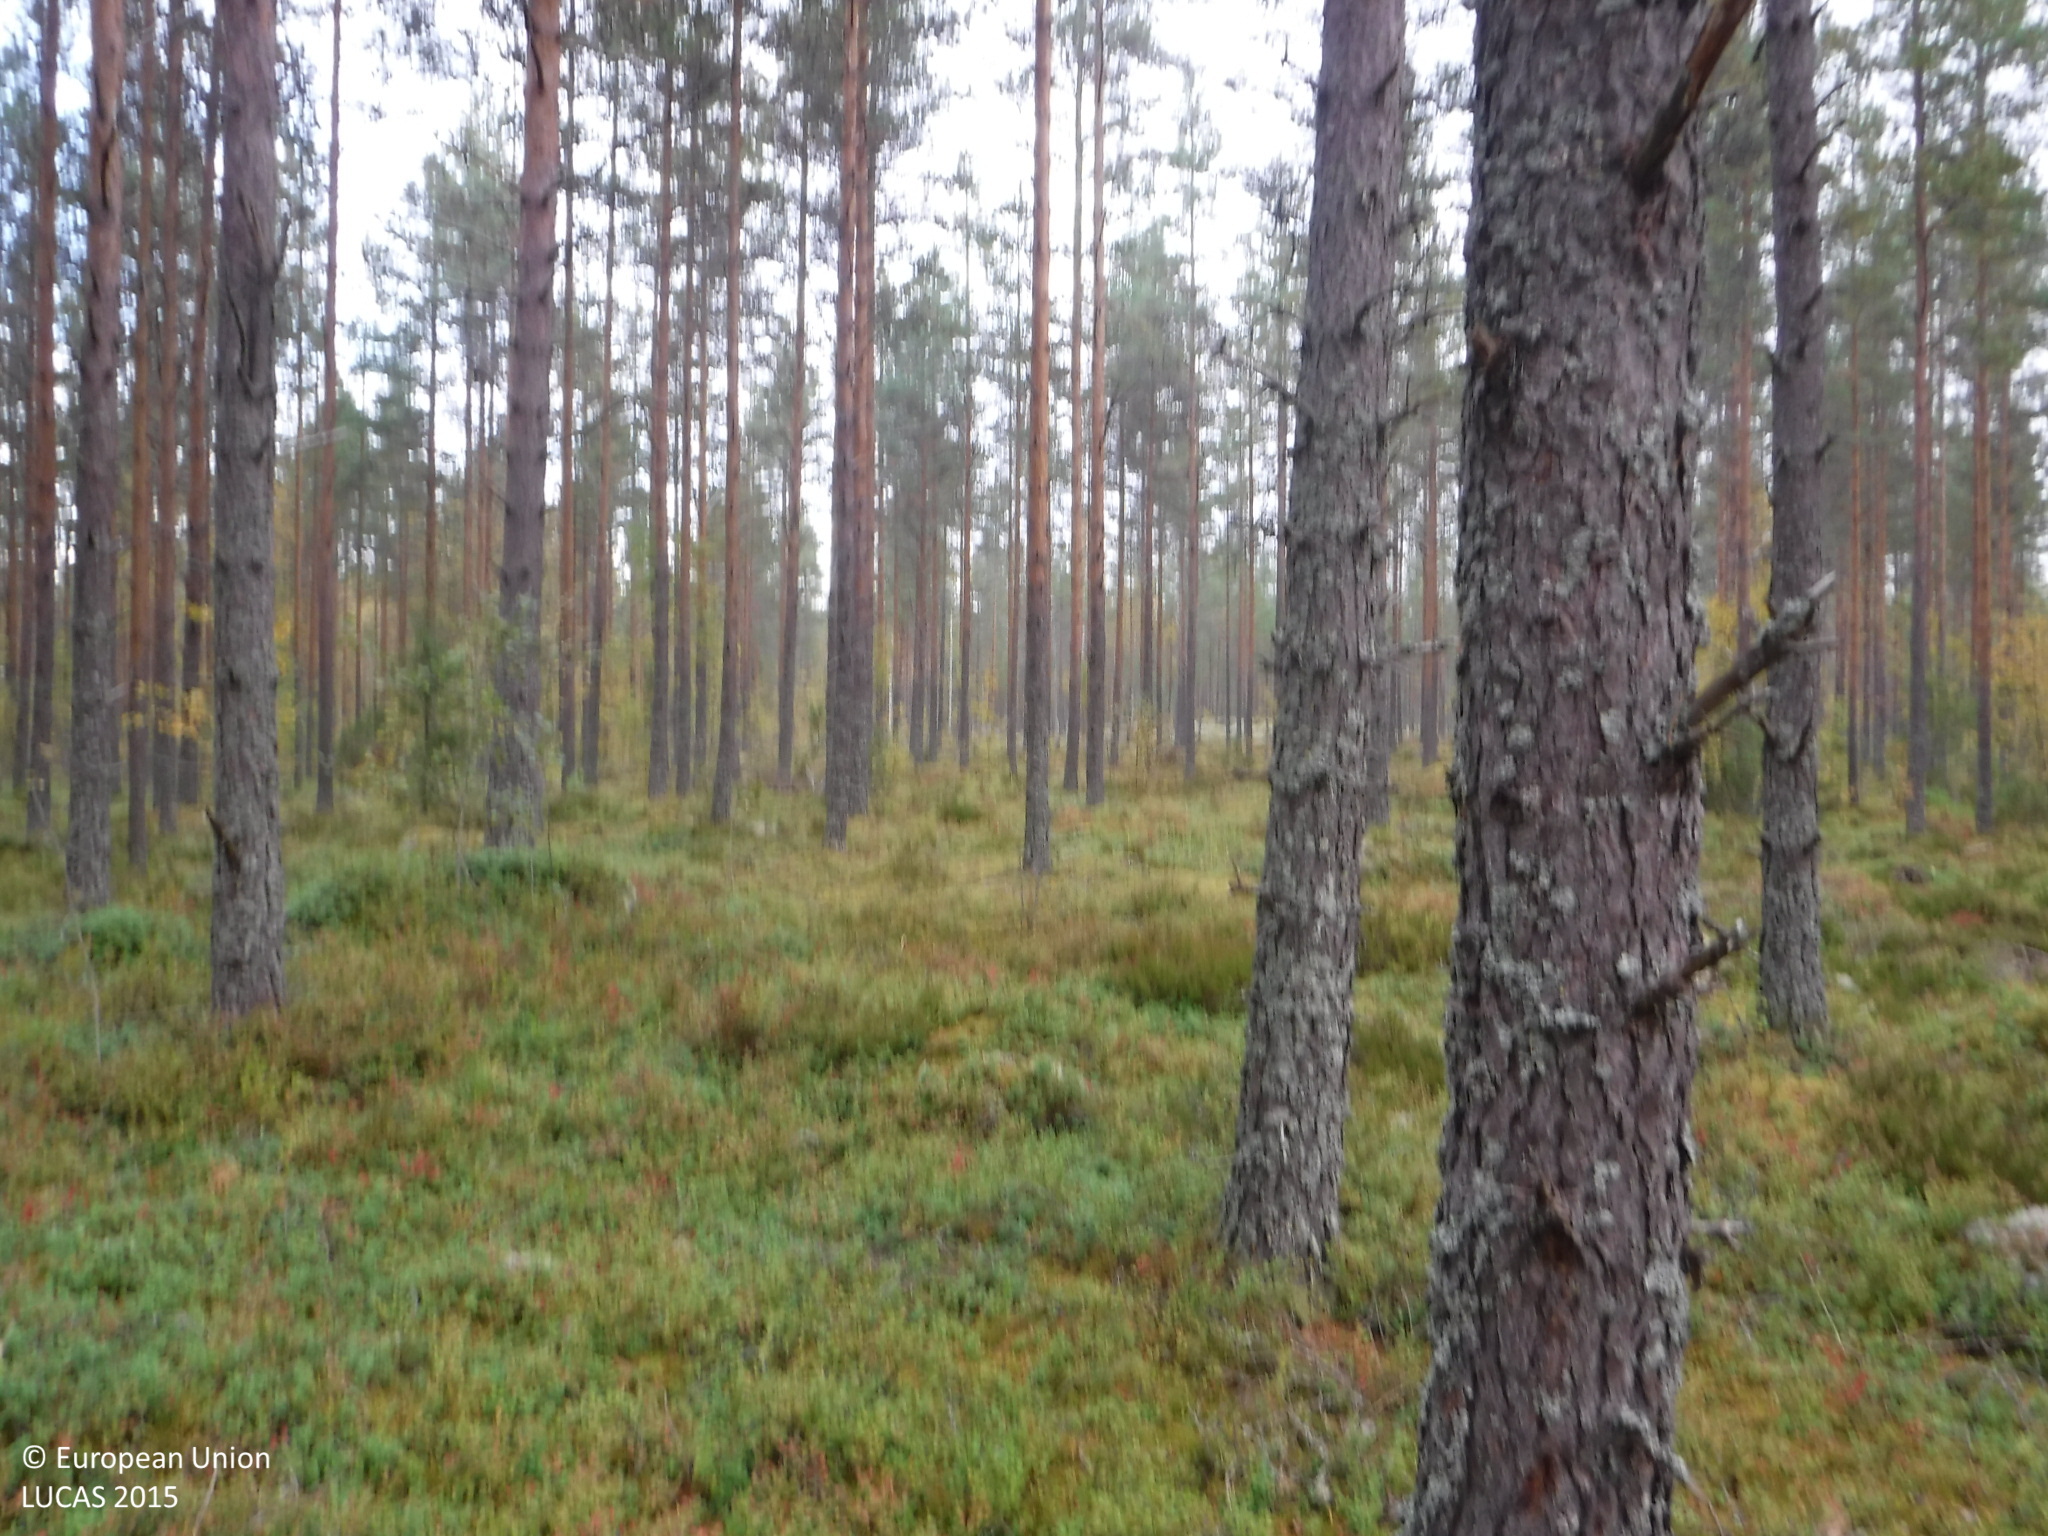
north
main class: Woodland
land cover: Pine dominated coniferous woodland
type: boreal forest
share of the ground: 25 - 50 %
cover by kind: coniferous forest trees 45 %, shrubs 30 %, lichens and mosses 25 %
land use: Forestry
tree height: > 5 m
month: September
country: FI
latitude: 61.9435
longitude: 22.2735
